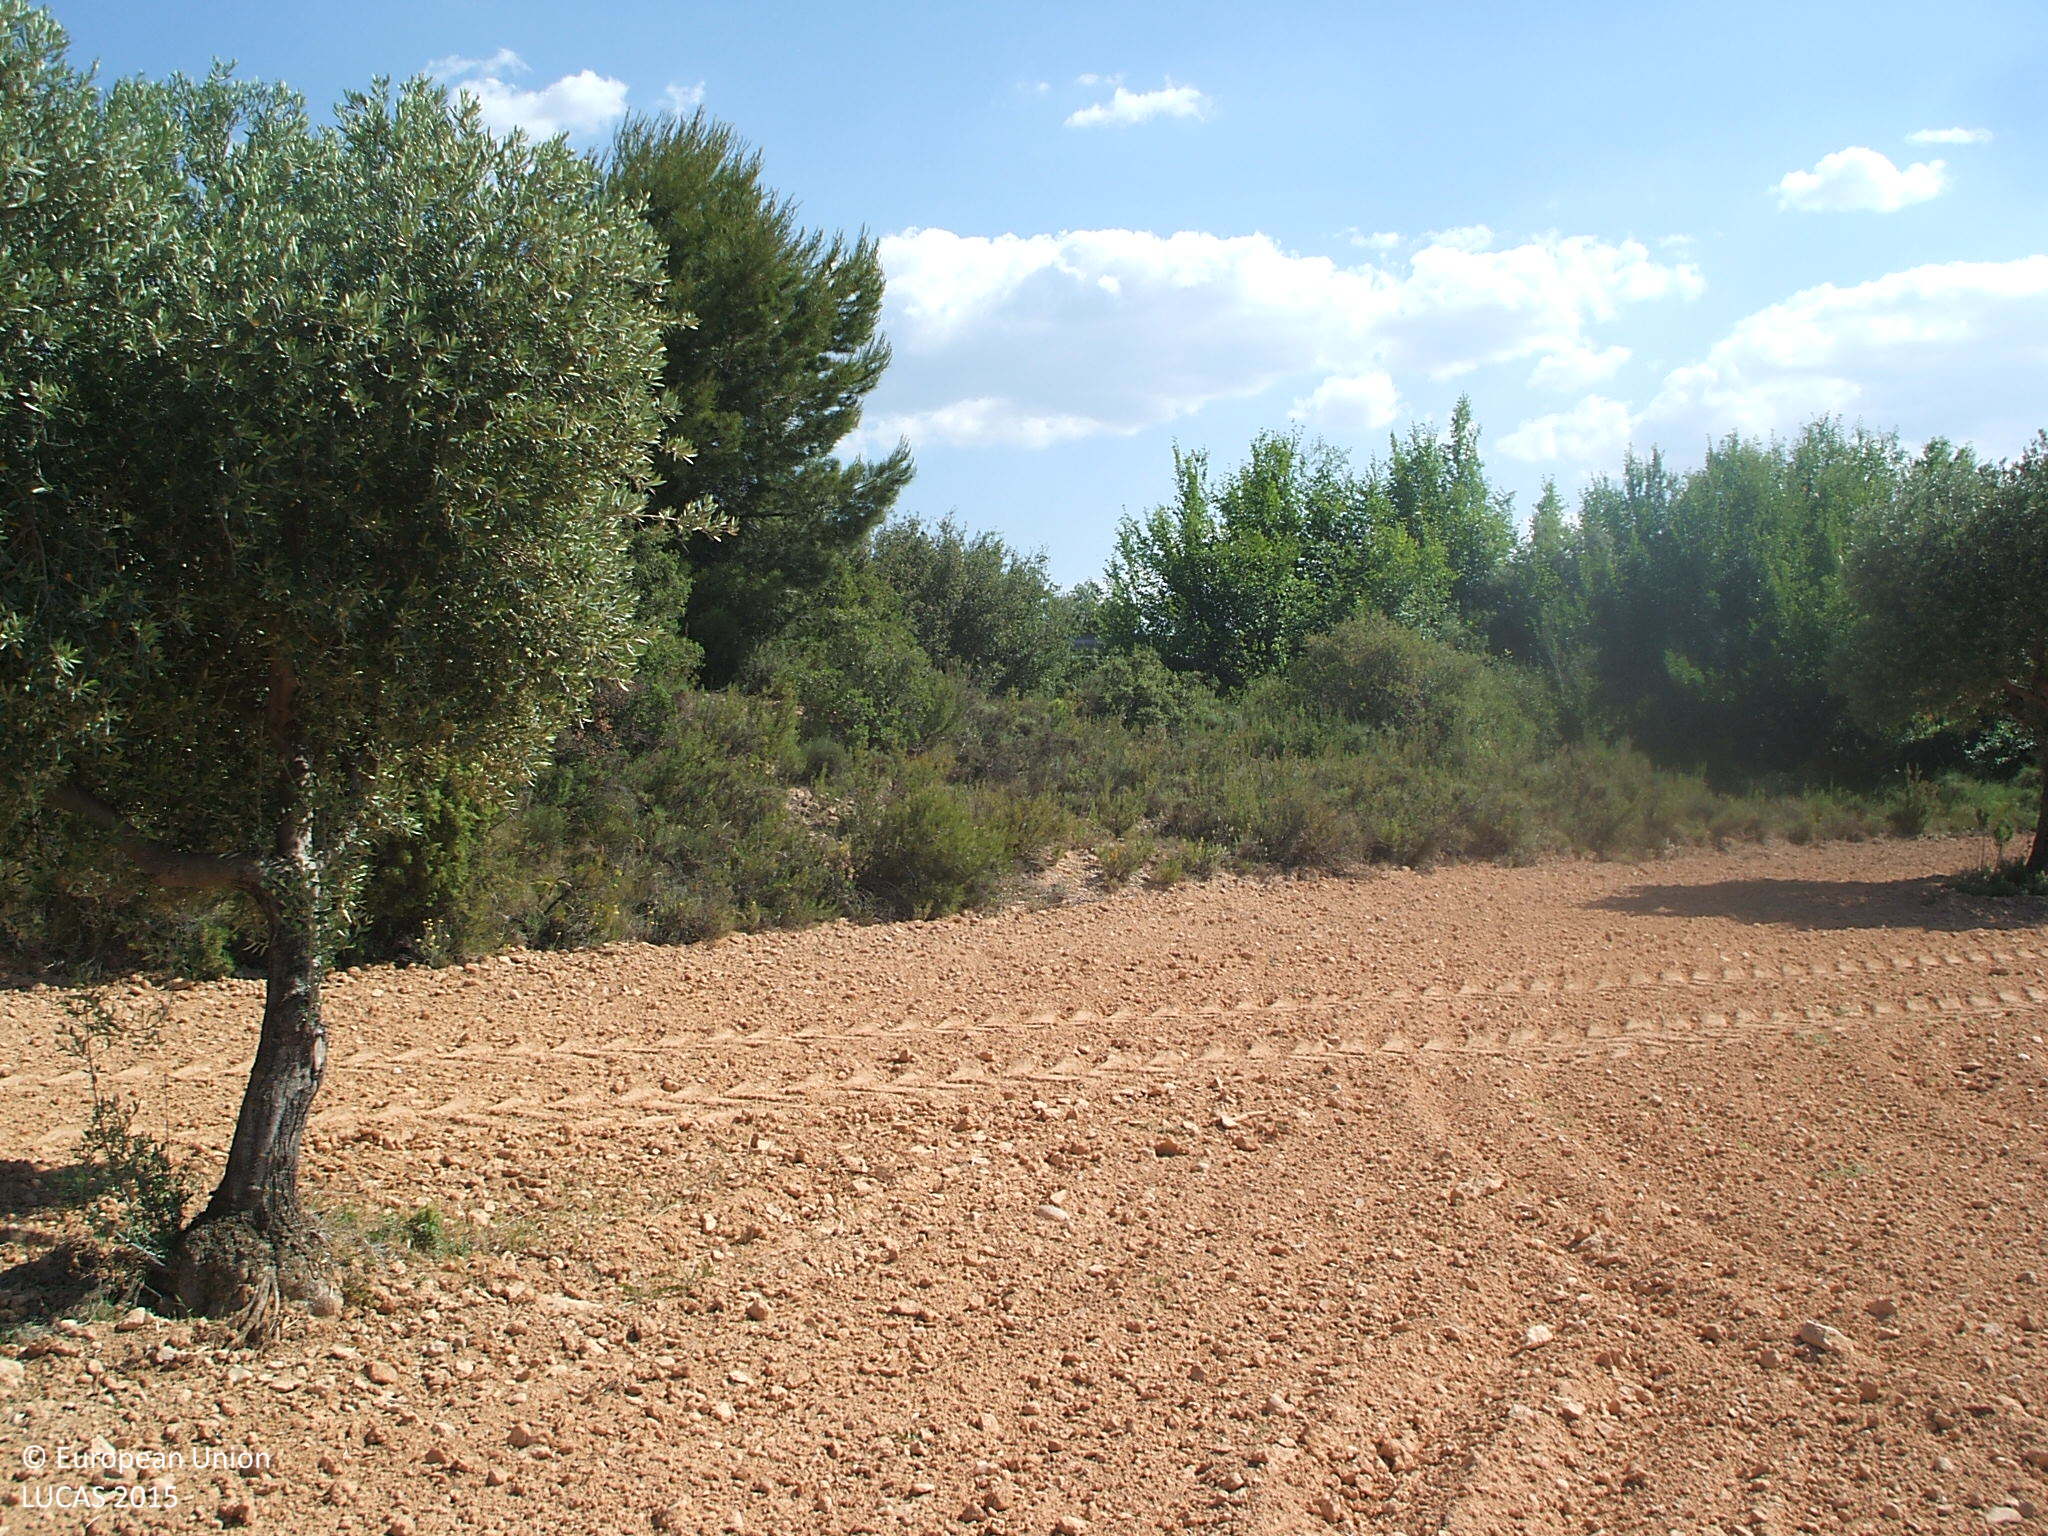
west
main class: Cropland
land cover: Olive groves
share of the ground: 10 - 25 %
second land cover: Other bare soil
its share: > 75 %
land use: Agriculture (excluding fallow land and kitchen gardens)
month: June
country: ES
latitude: 40.9725
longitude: -0.0280
